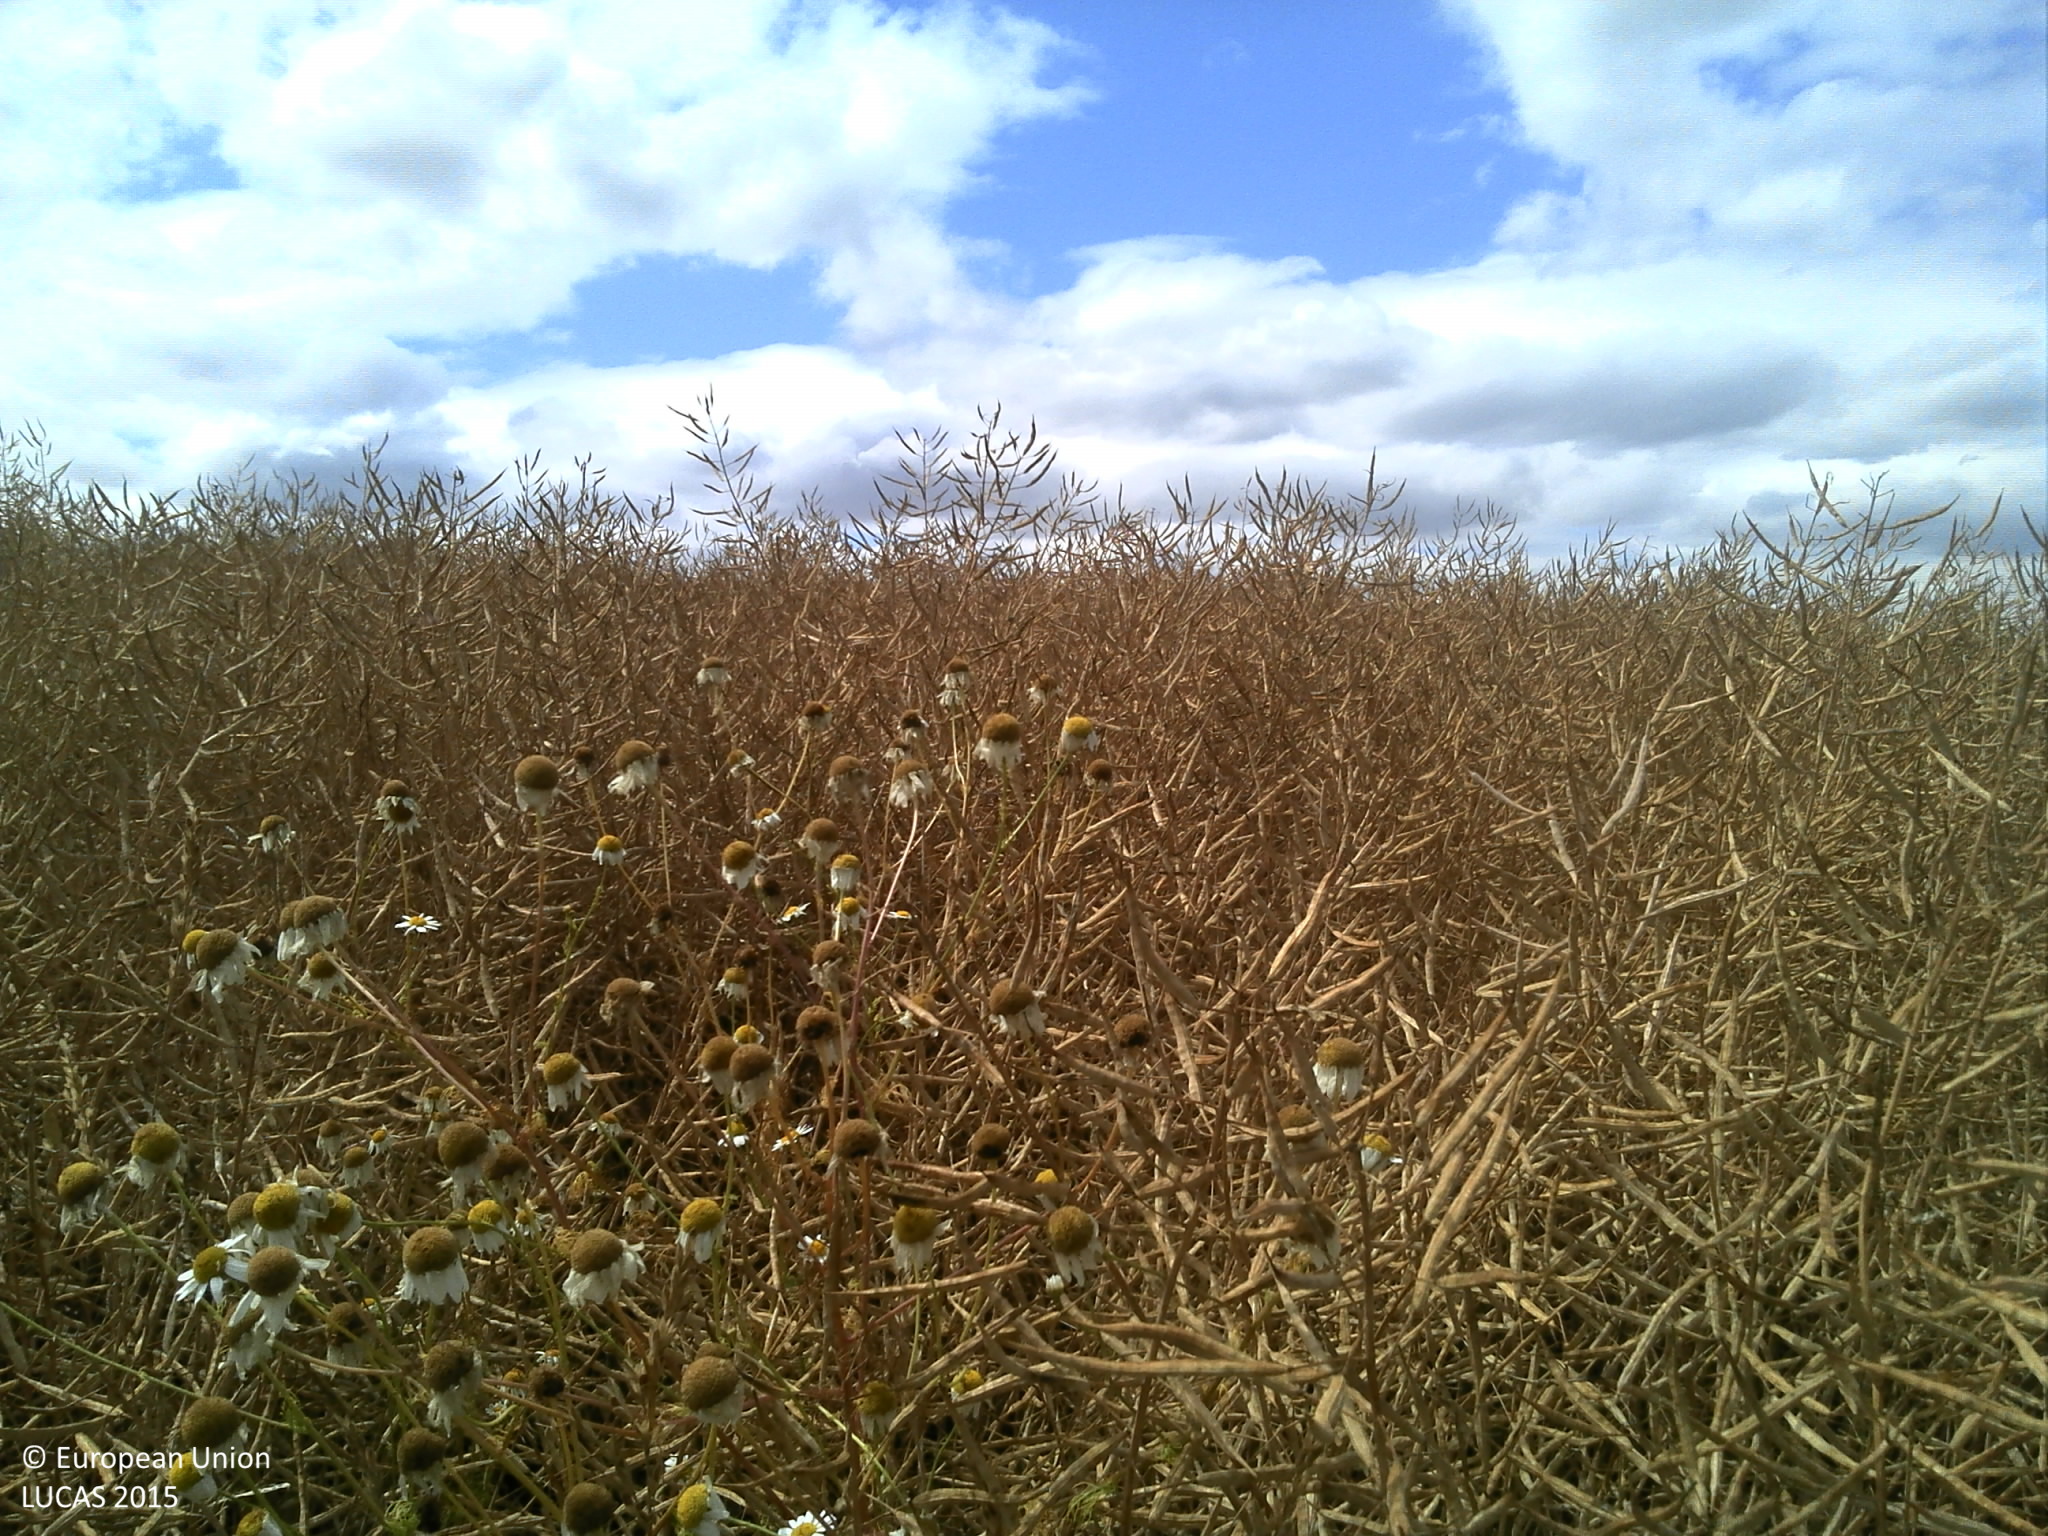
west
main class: Cropland
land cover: Rape and turnip rape
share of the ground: > 75 %
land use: Agriculture (excluding fallow land and kitchen gardens)
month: July
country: FR
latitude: 49.3451
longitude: 4.8080
